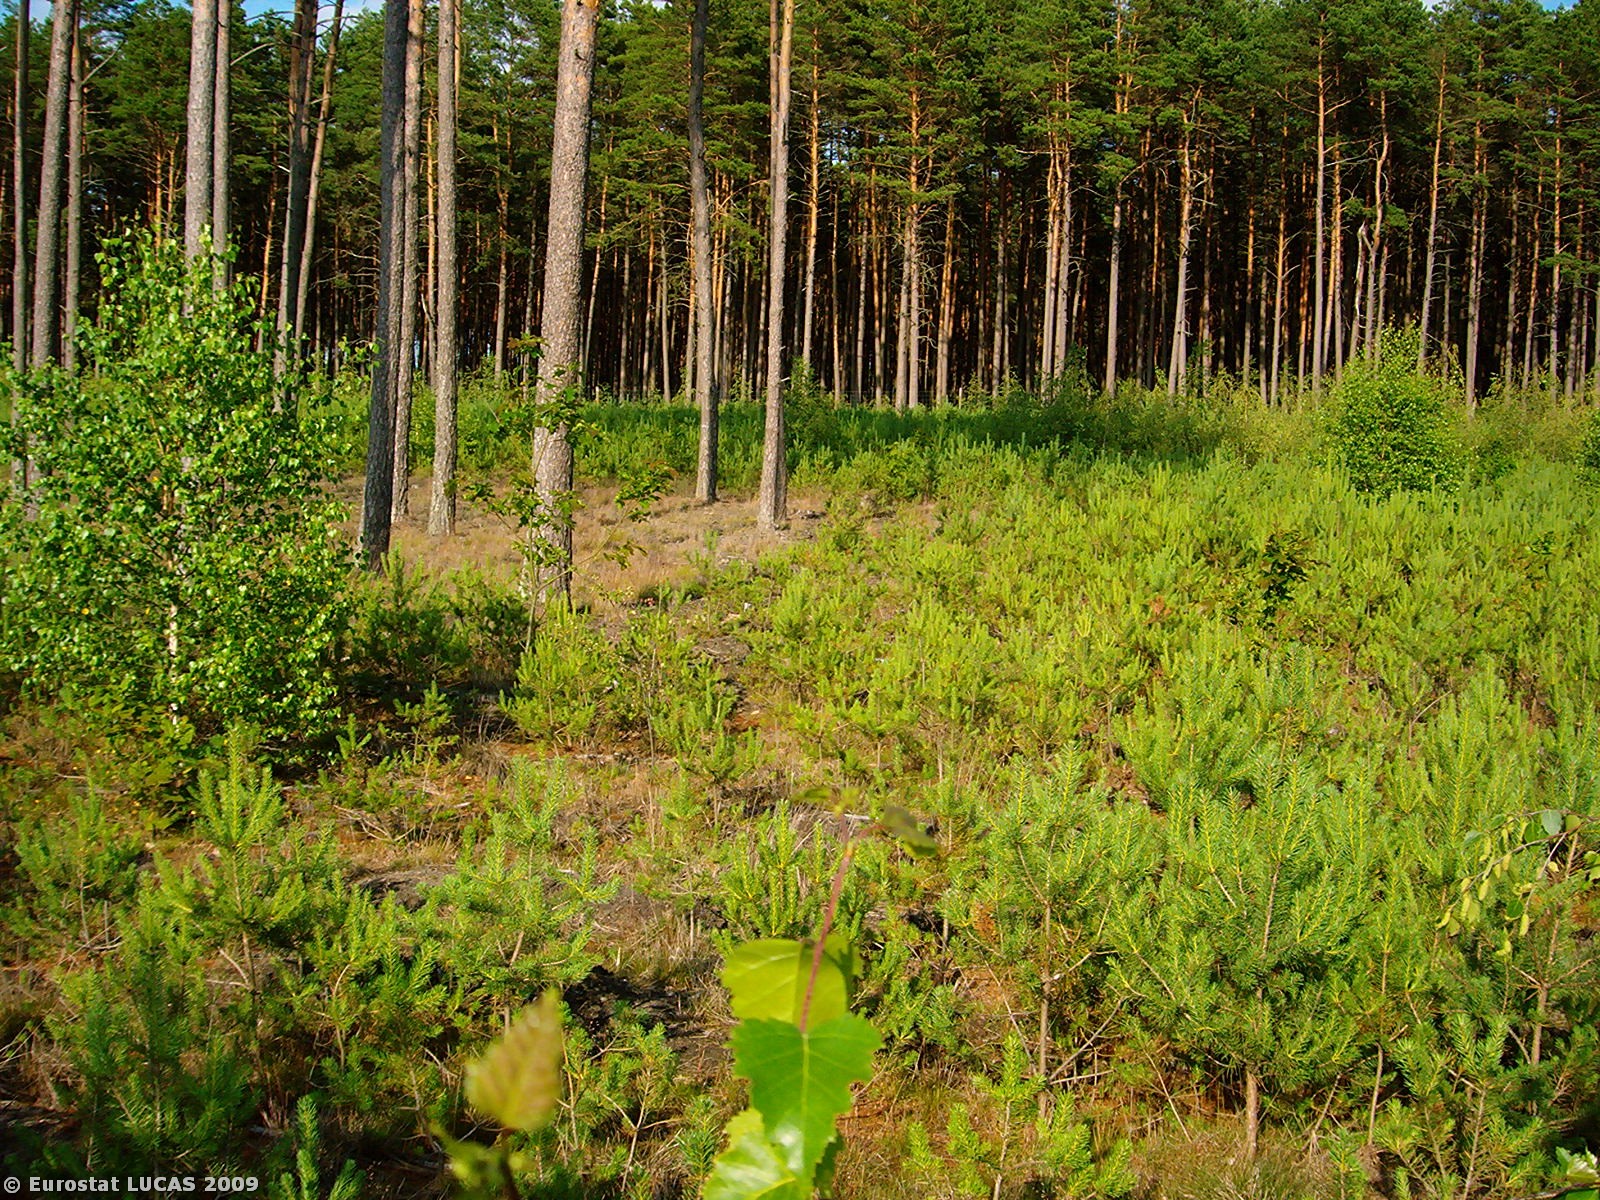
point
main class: Woodland
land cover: Mixed woodland
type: hemiboreal forest and nemoral coniferous forest and mixed broadleaved-coniferous forest
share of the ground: 25 - 50 %
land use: Forestry
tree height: > 5 m
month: June
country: PL
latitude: 53.2017
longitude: 15.9482
